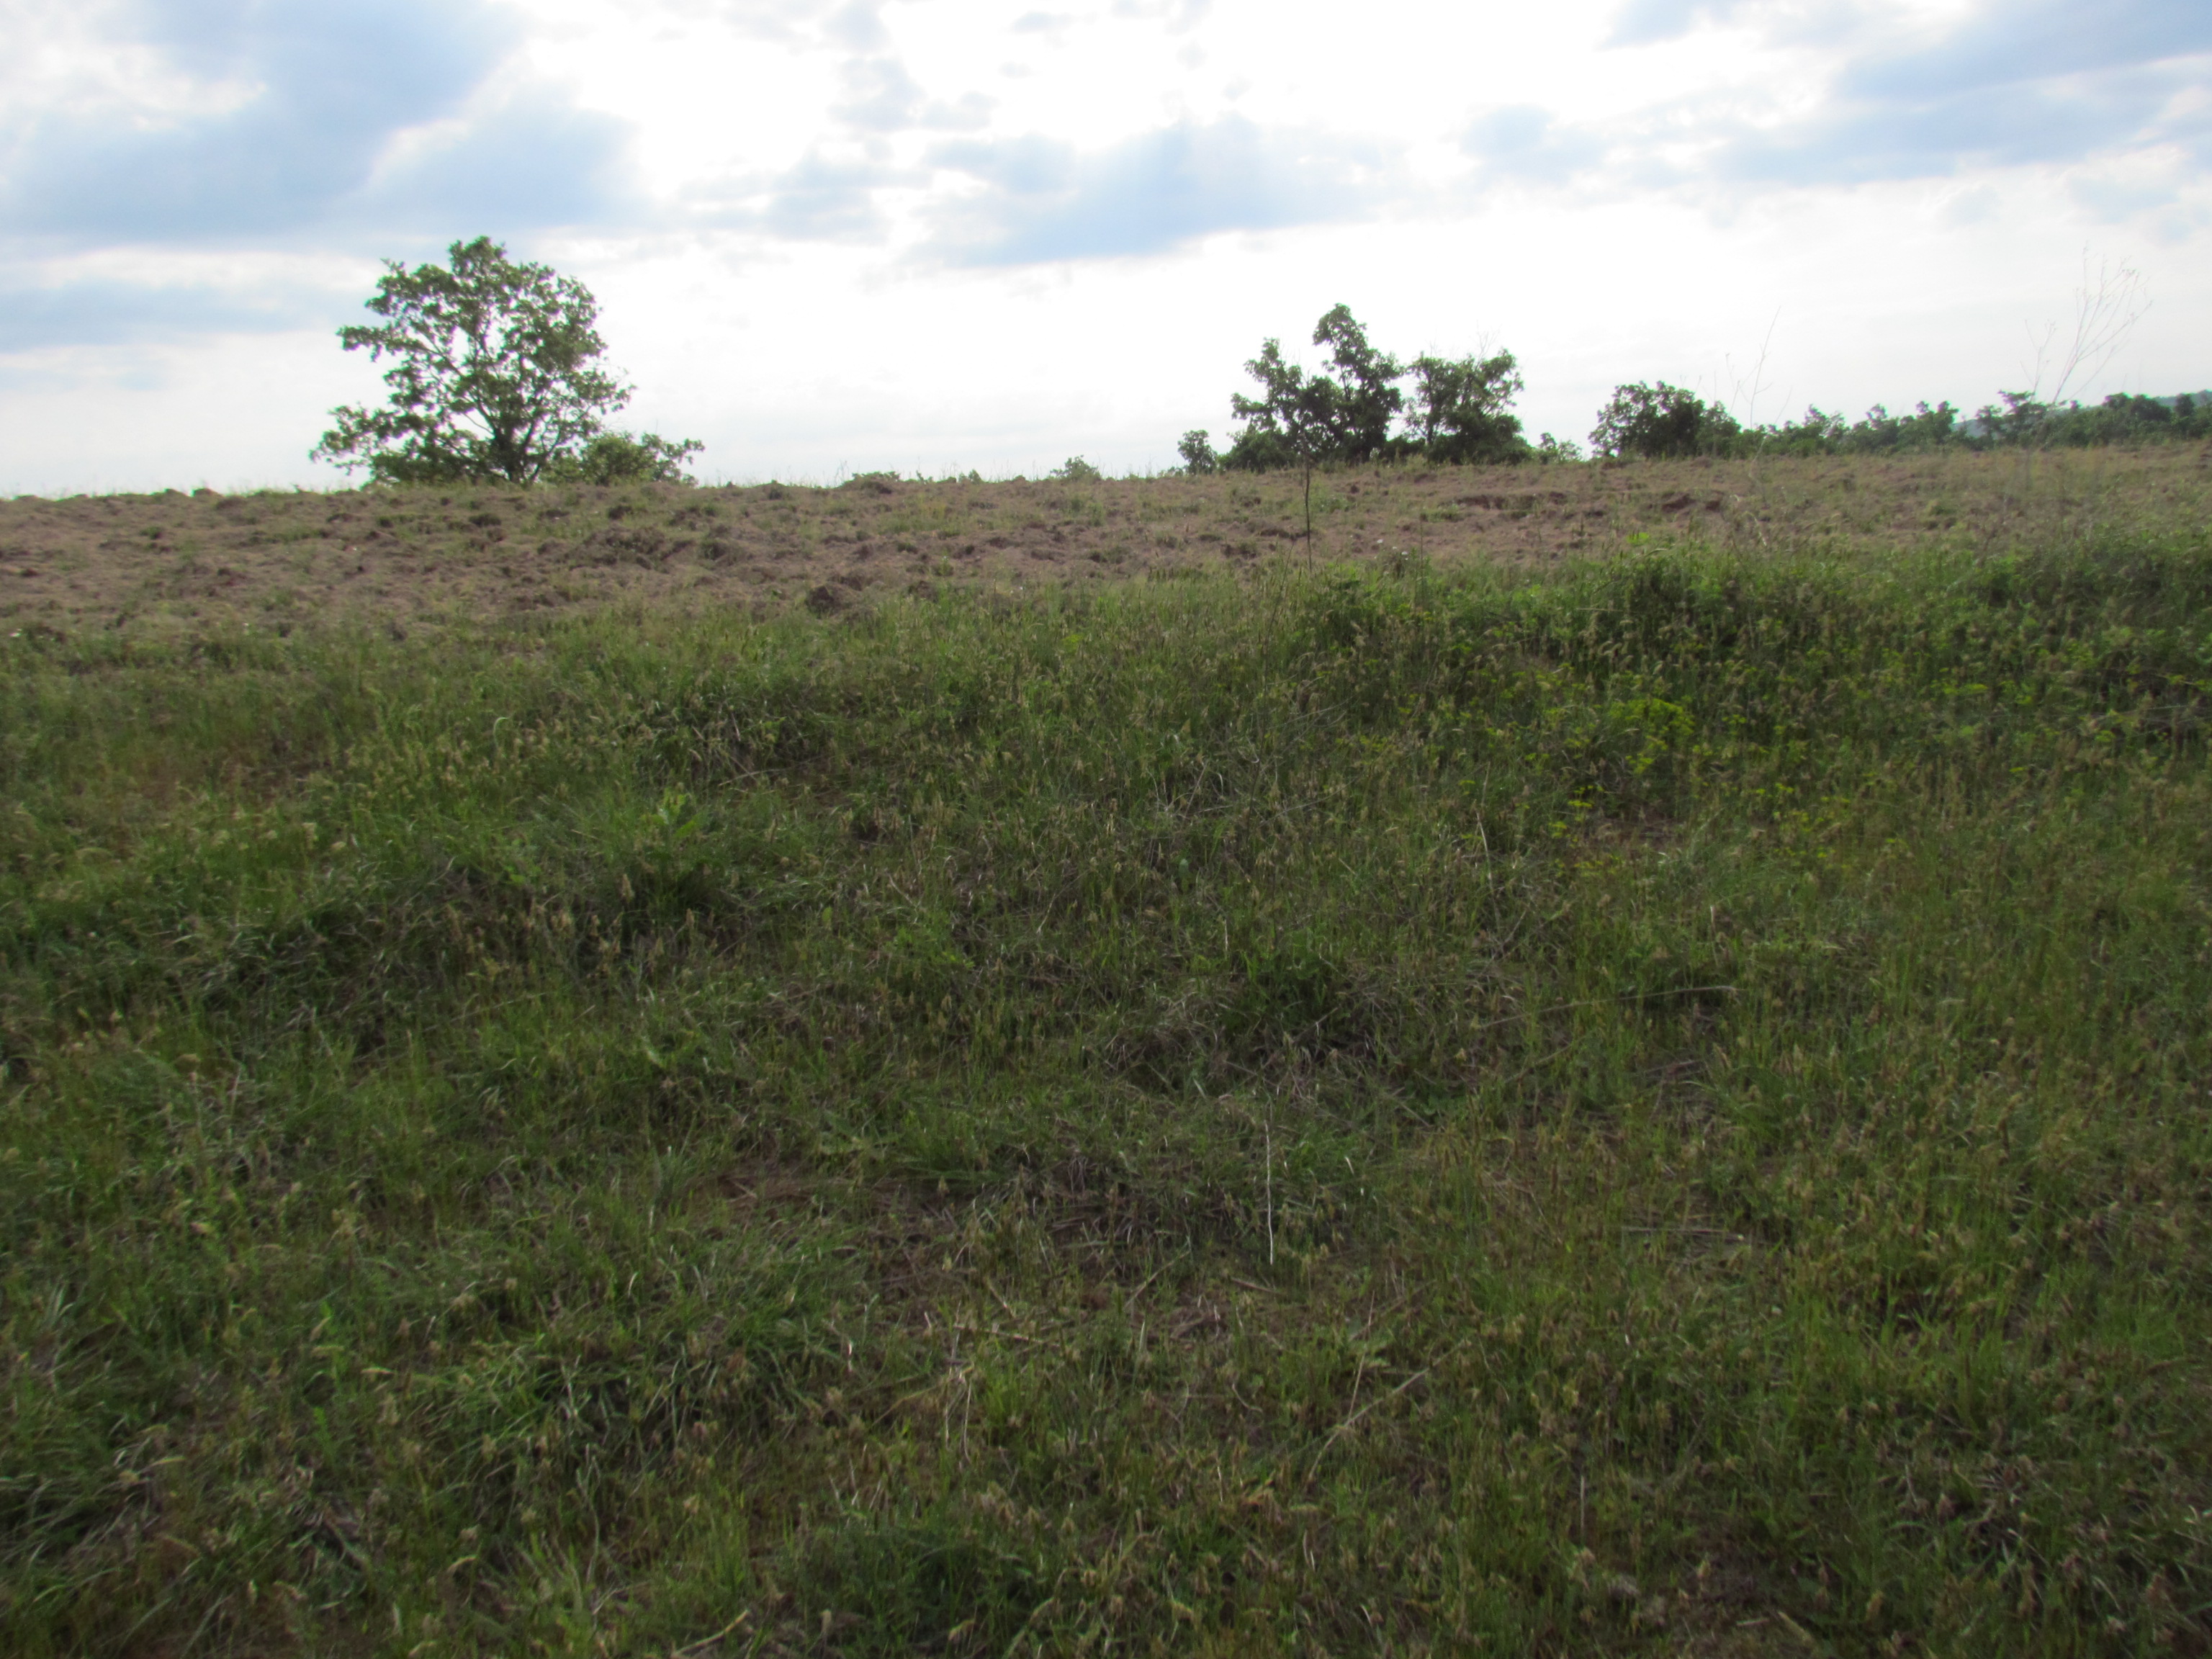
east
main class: Grassland
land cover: Grassland with sparse tree/shrub cover
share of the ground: > 75 %
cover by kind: herbaceous plants 90 %, broadleaved forest trees 5 %, shrubs 5 %
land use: Agriculture (excluding fallow land and kitchen gardens)
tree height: > 5 m
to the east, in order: Grassland with sparse tree/shrub cover; Other bare soil; Grassland with sparse tree/shrub cover; Shrubland with sparse tree cover; Broadleaved woodland; Other bare soil; Broadleaved woodland; Other bare soil; Grassland with sparse tree/shrub cover; Broadleaved woodland; Grassland with sparse tree/shrub cover
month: May
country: BG
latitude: 42.2630
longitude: 27.1624
